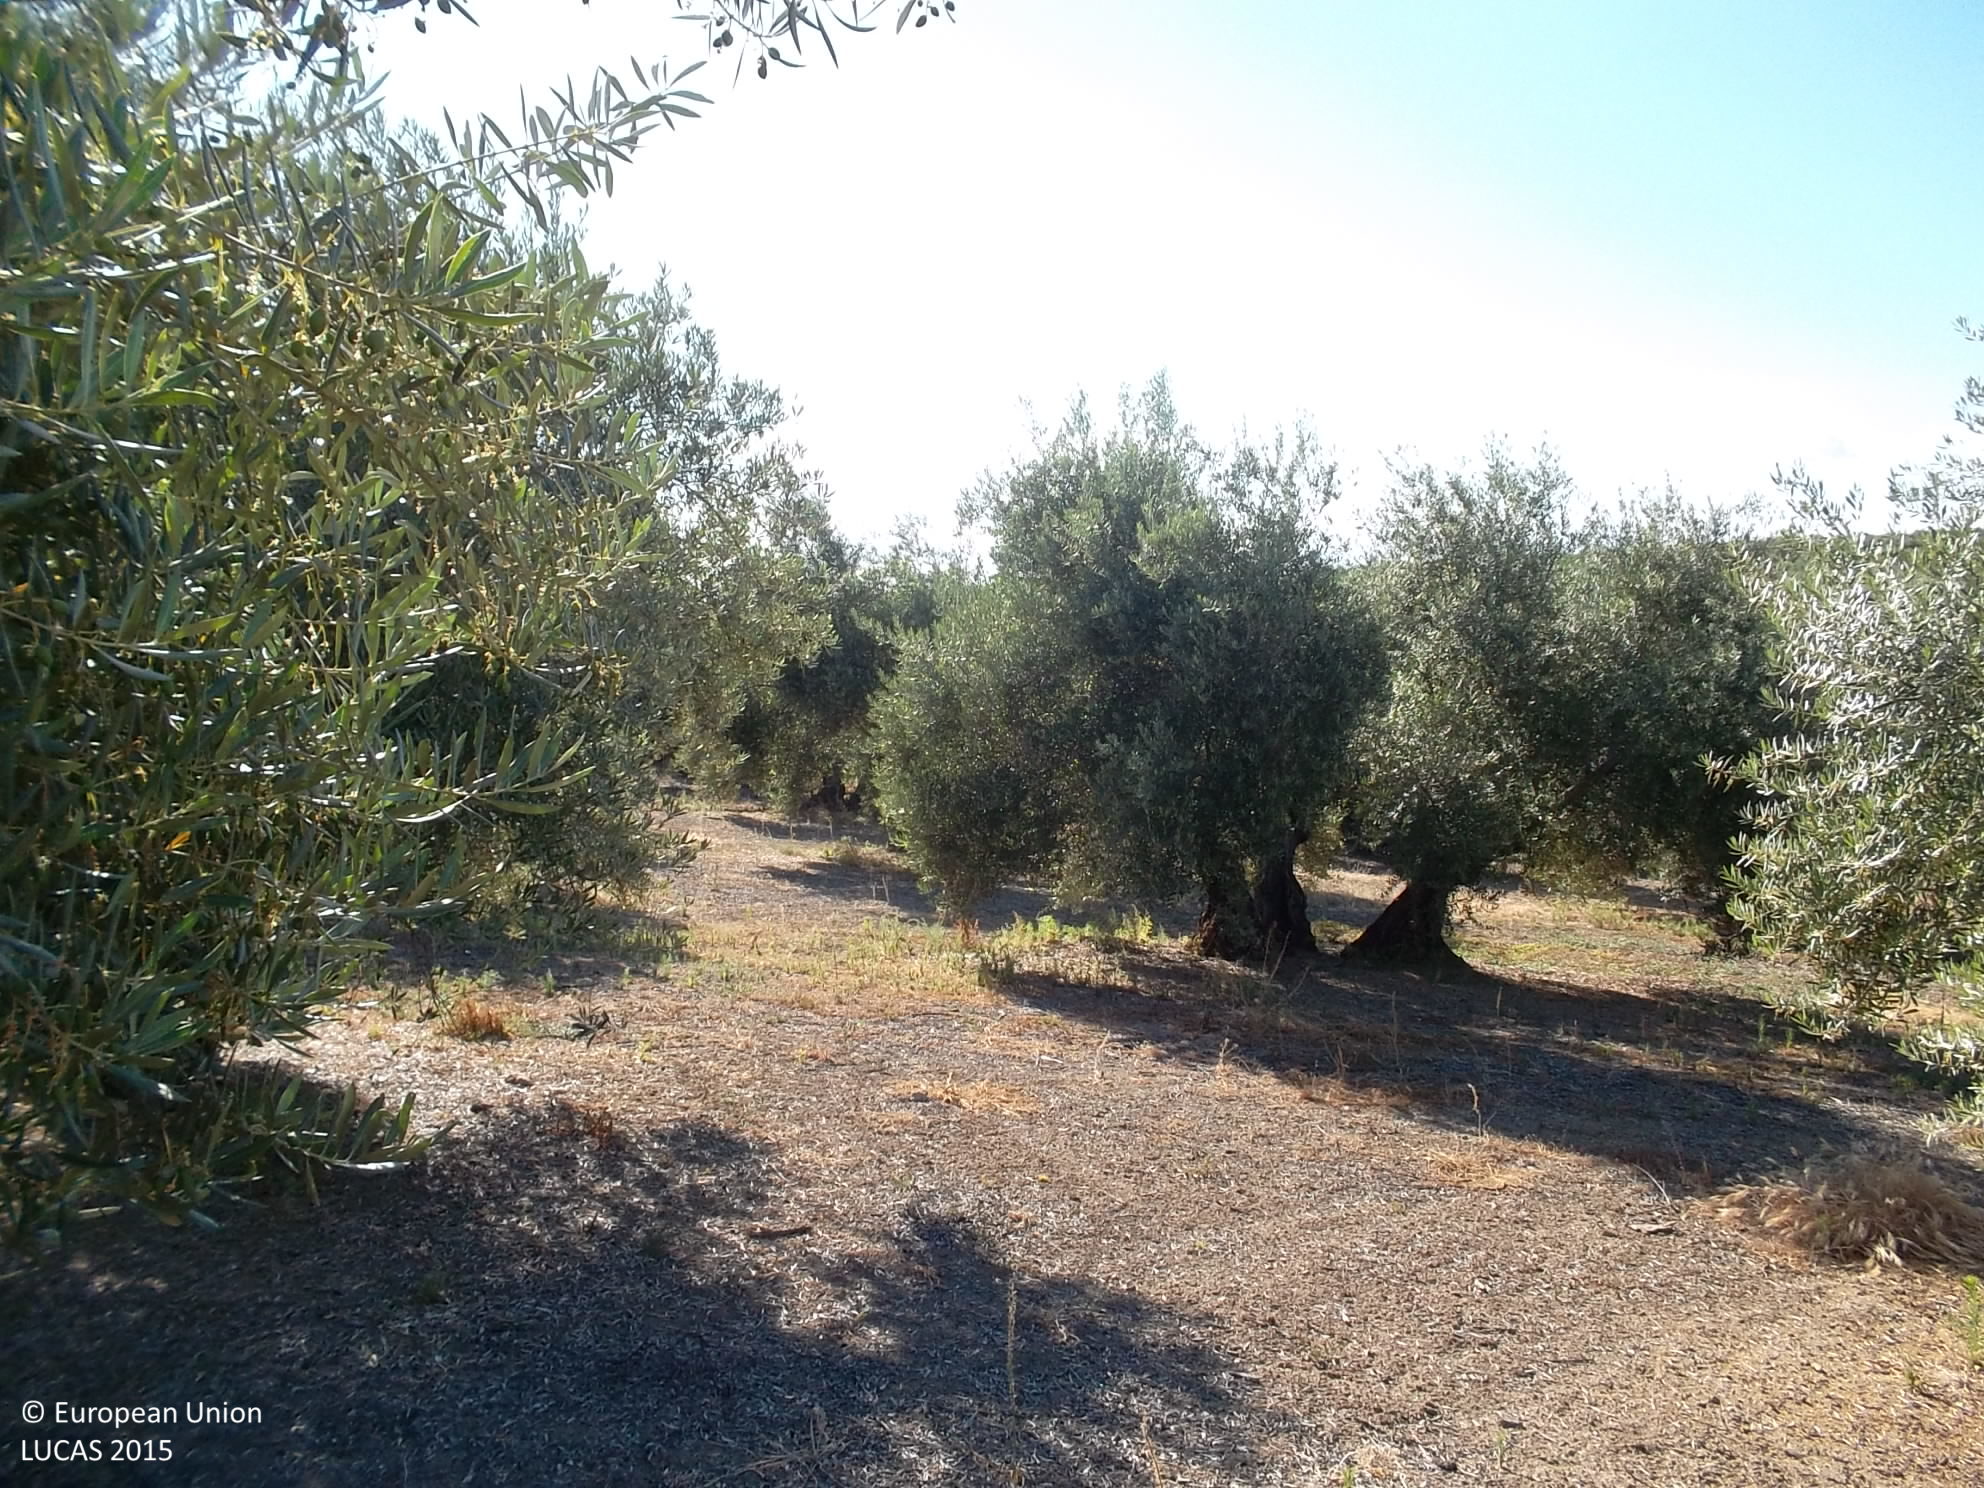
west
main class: Cropland
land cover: Olive groves
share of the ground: 50 - 75 %
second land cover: Other bare soil
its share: > 75 %
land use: Agriculture (excluding fallow land and kitchen gardens)
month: June
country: ES
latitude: 37.9983
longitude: -3.0586
